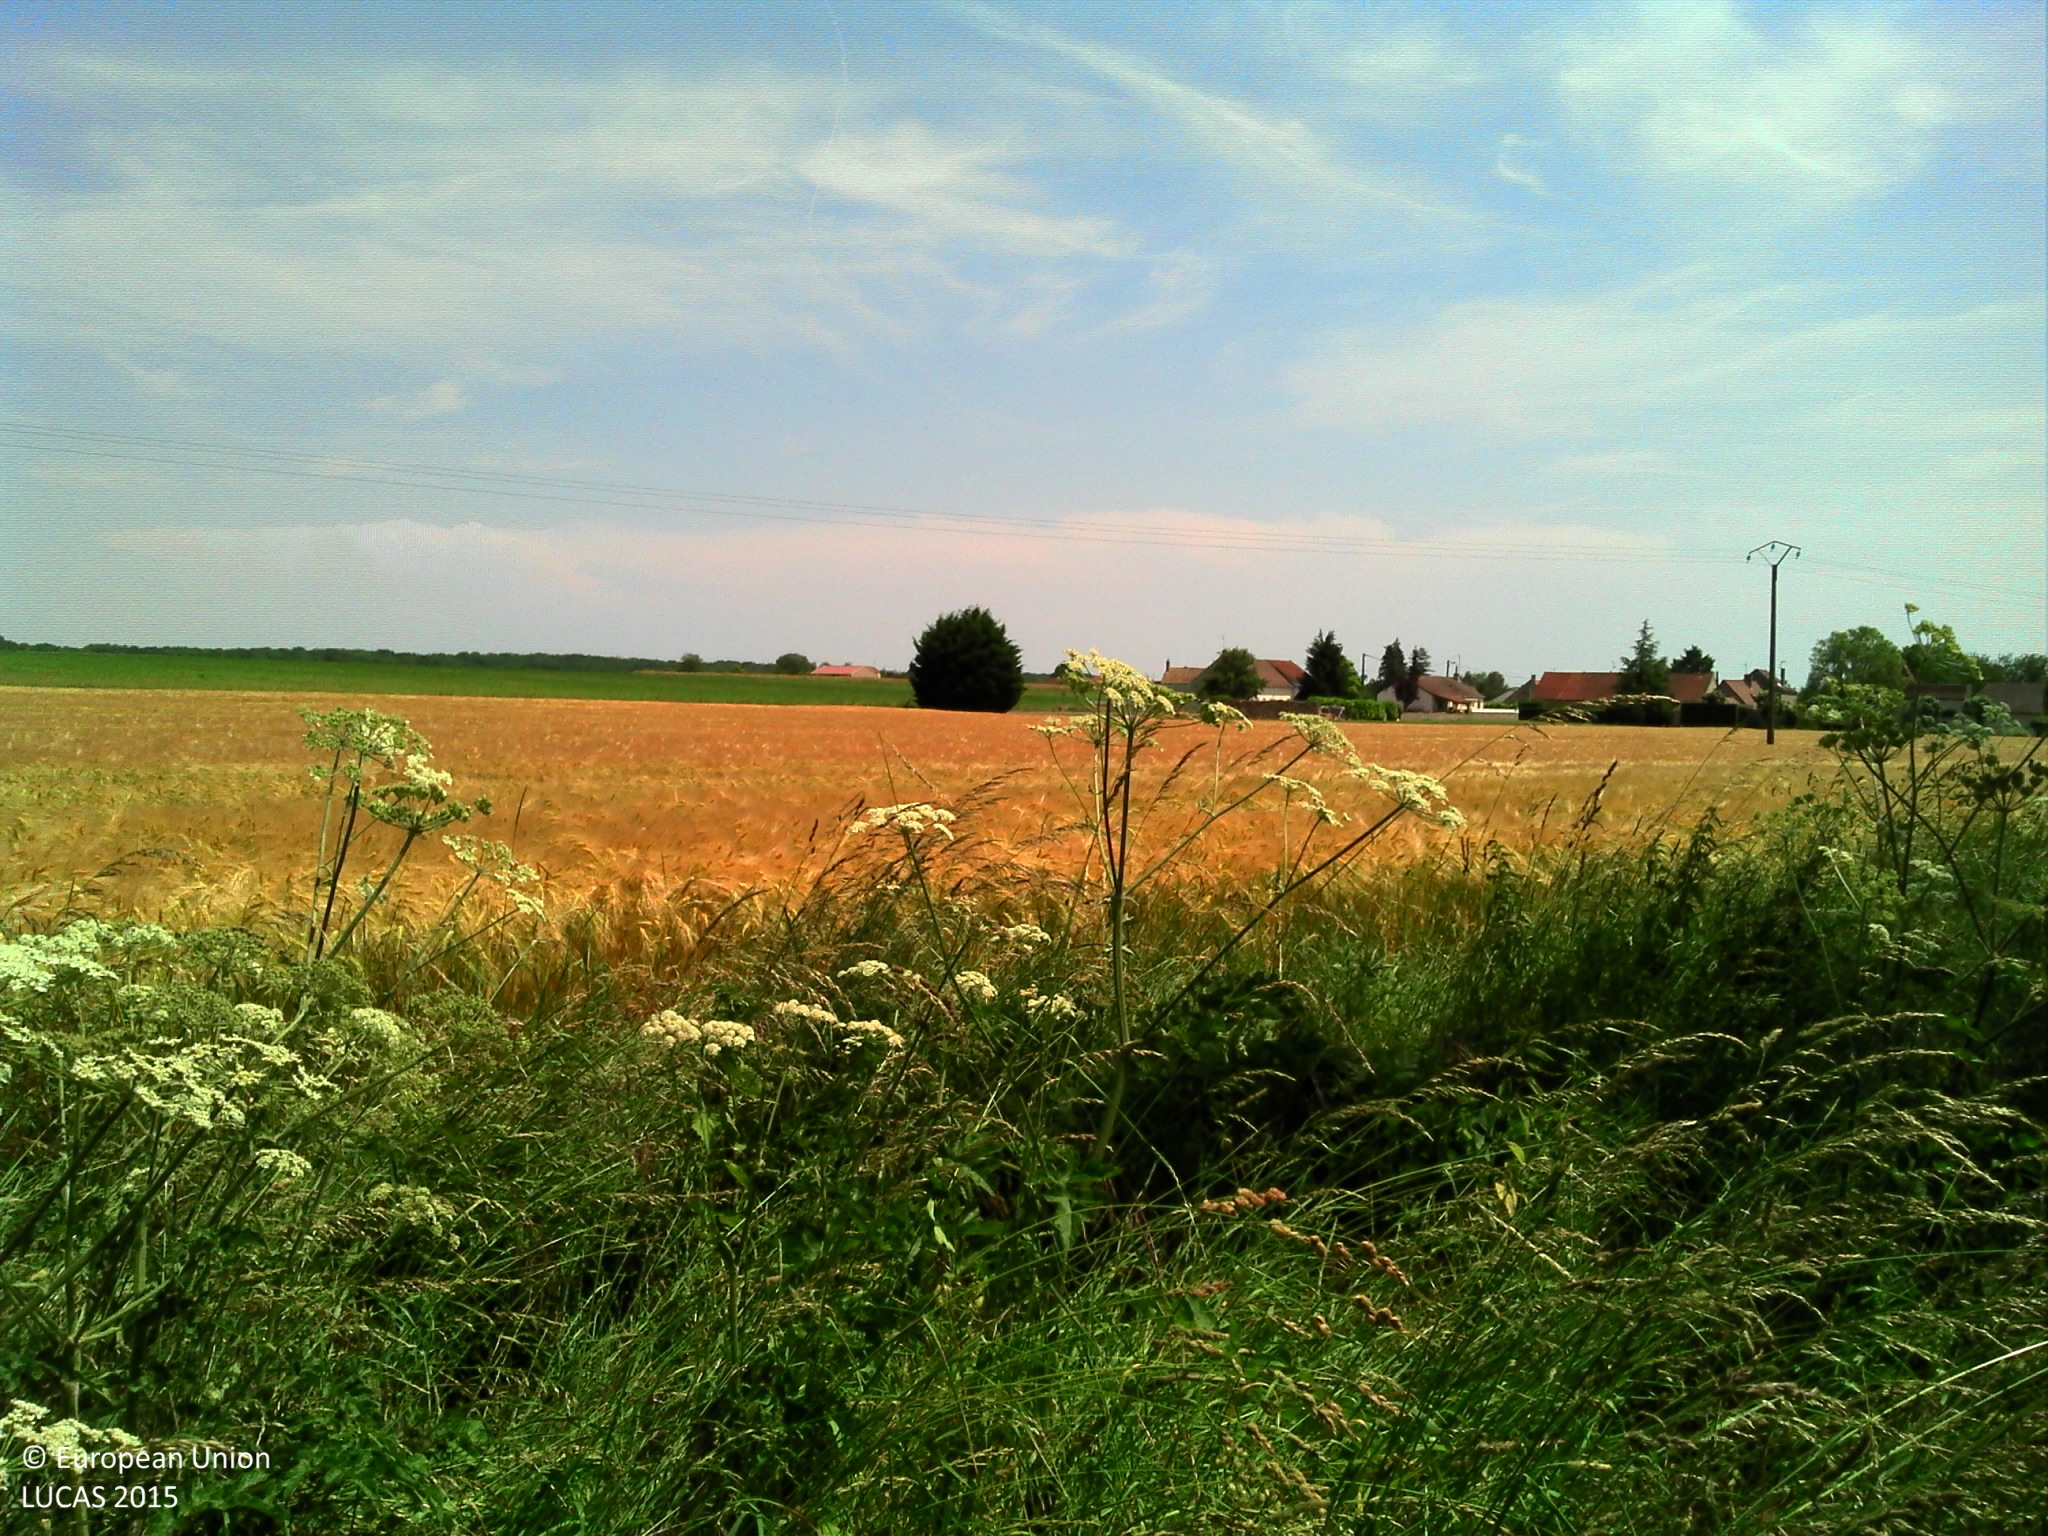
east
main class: Grassland
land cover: Spontaneously vegetated surfaces
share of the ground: > 75 %
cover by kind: herbaceous plants 95 %, shrubs 5 %
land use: Semi-natural and natural areas not in use
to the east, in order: Spontaneously vegetated surfaces; Barley; Electric lines; Barley; Grass margins; Paved roads, cycling and walking lanes; Grass margins; Ditches and canals; Soya; Maize
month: June
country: FR
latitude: 47.0239
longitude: 4.9091
